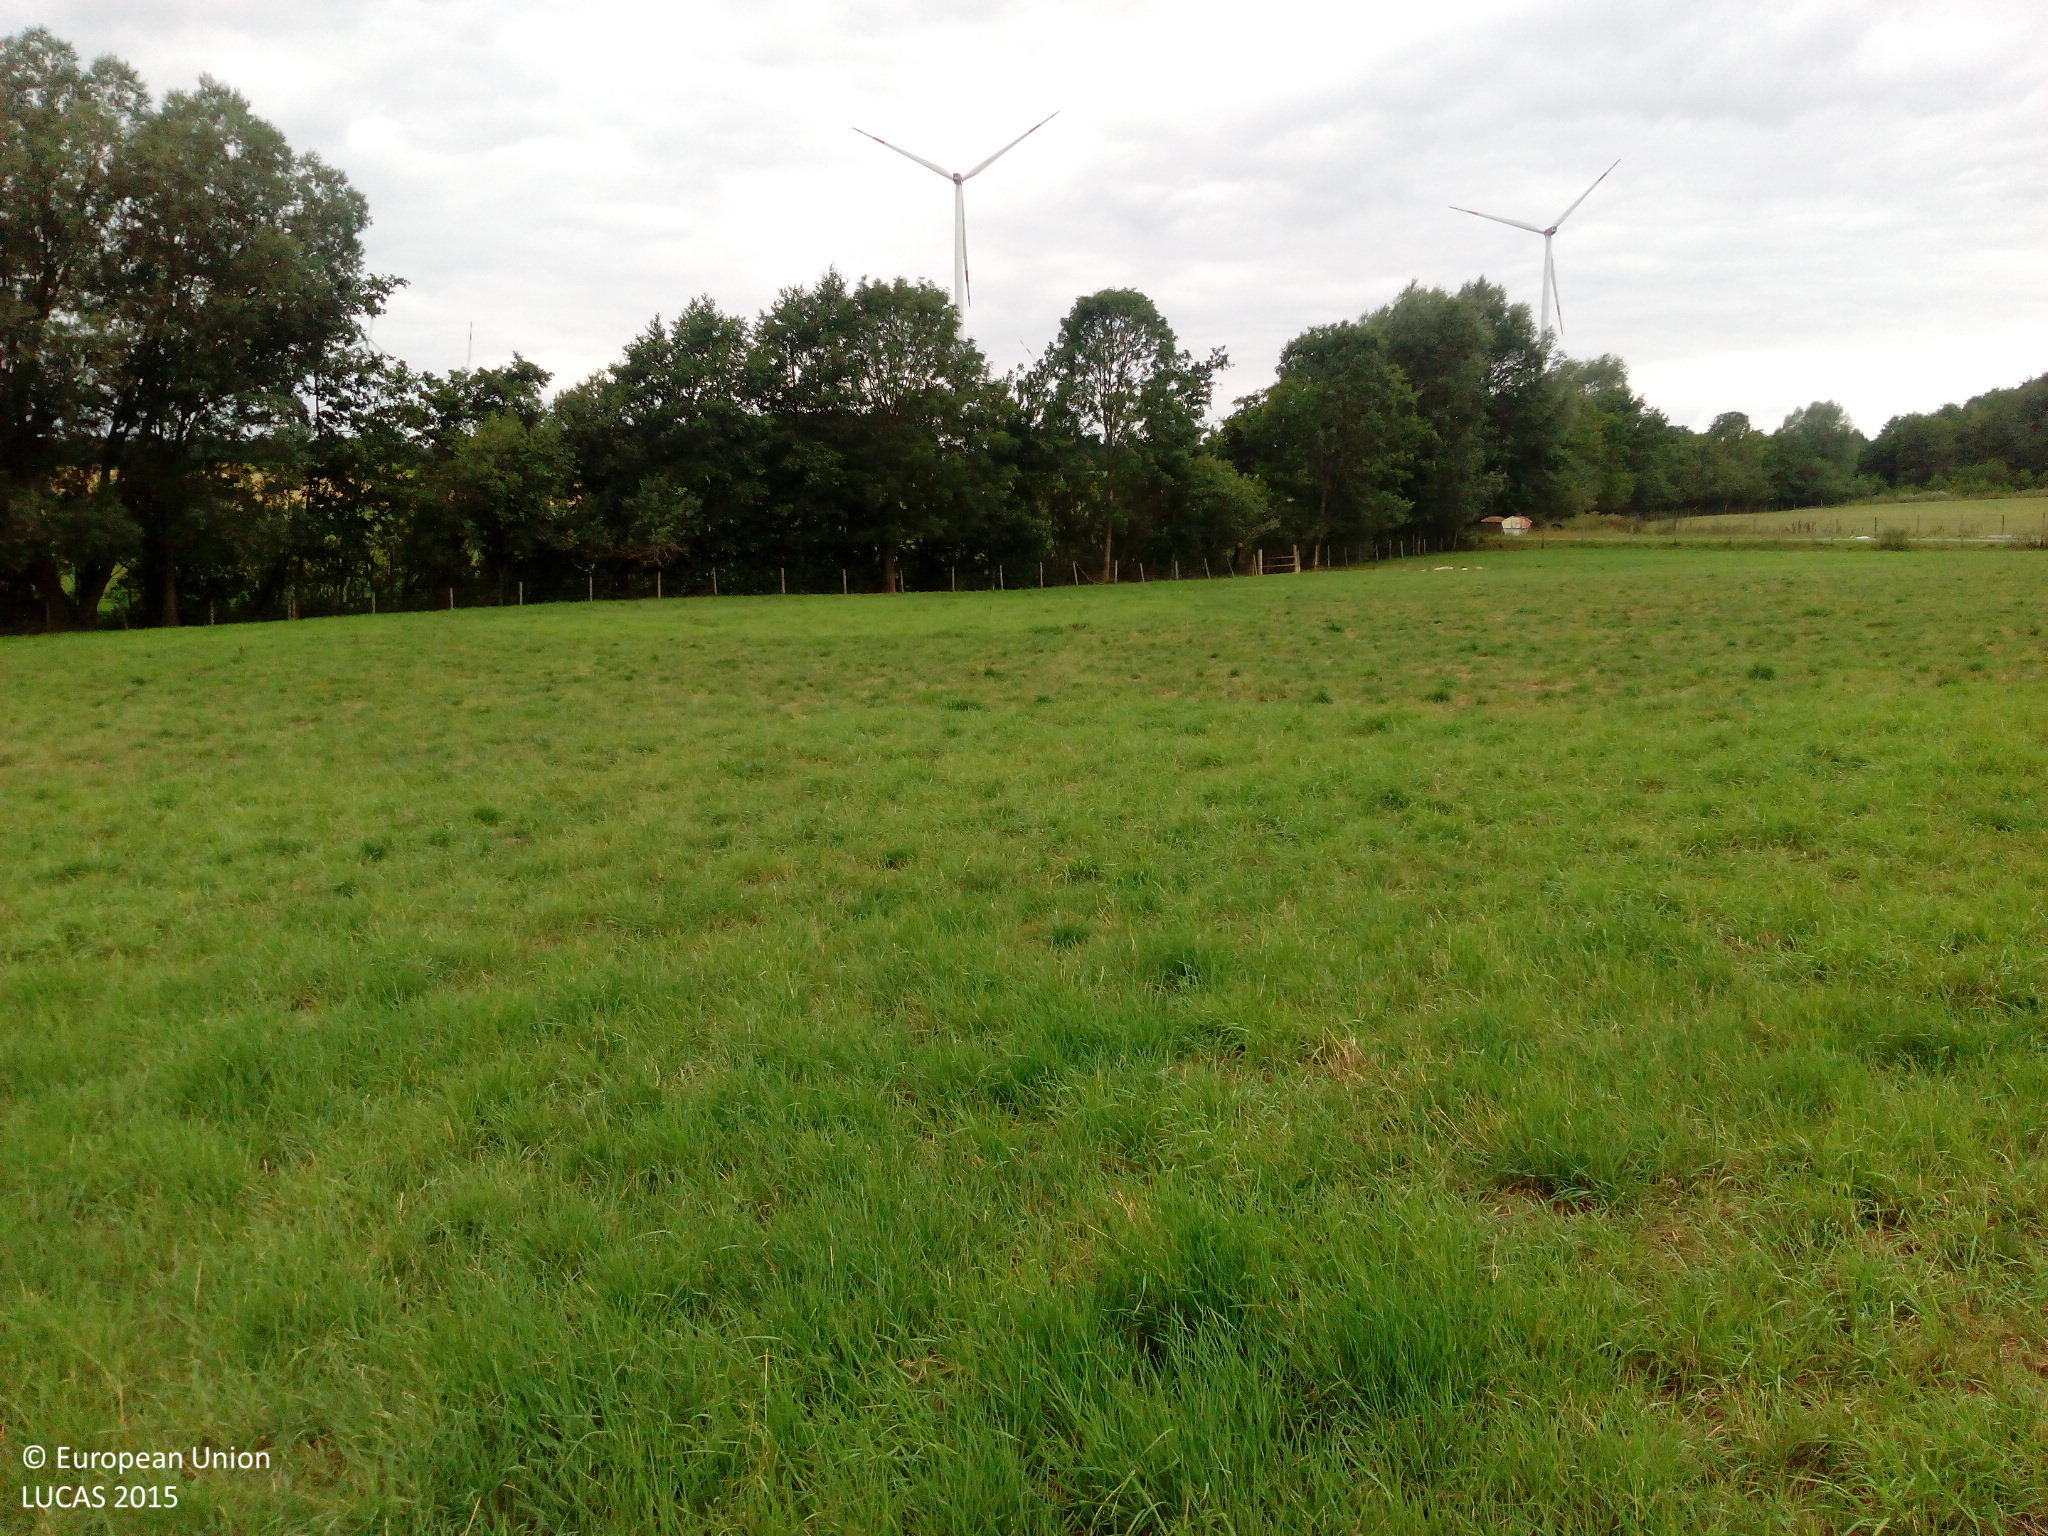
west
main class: Grassland
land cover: Grassland without tree/shrub cover
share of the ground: > 75 %
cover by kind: herbaceous plants 95 %, unconsolidated bare surface 5 %
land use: Agriculture (excluding fallow land and kitchen gardens)
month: August
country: DE
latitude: 50.0489
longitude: 7.5005
